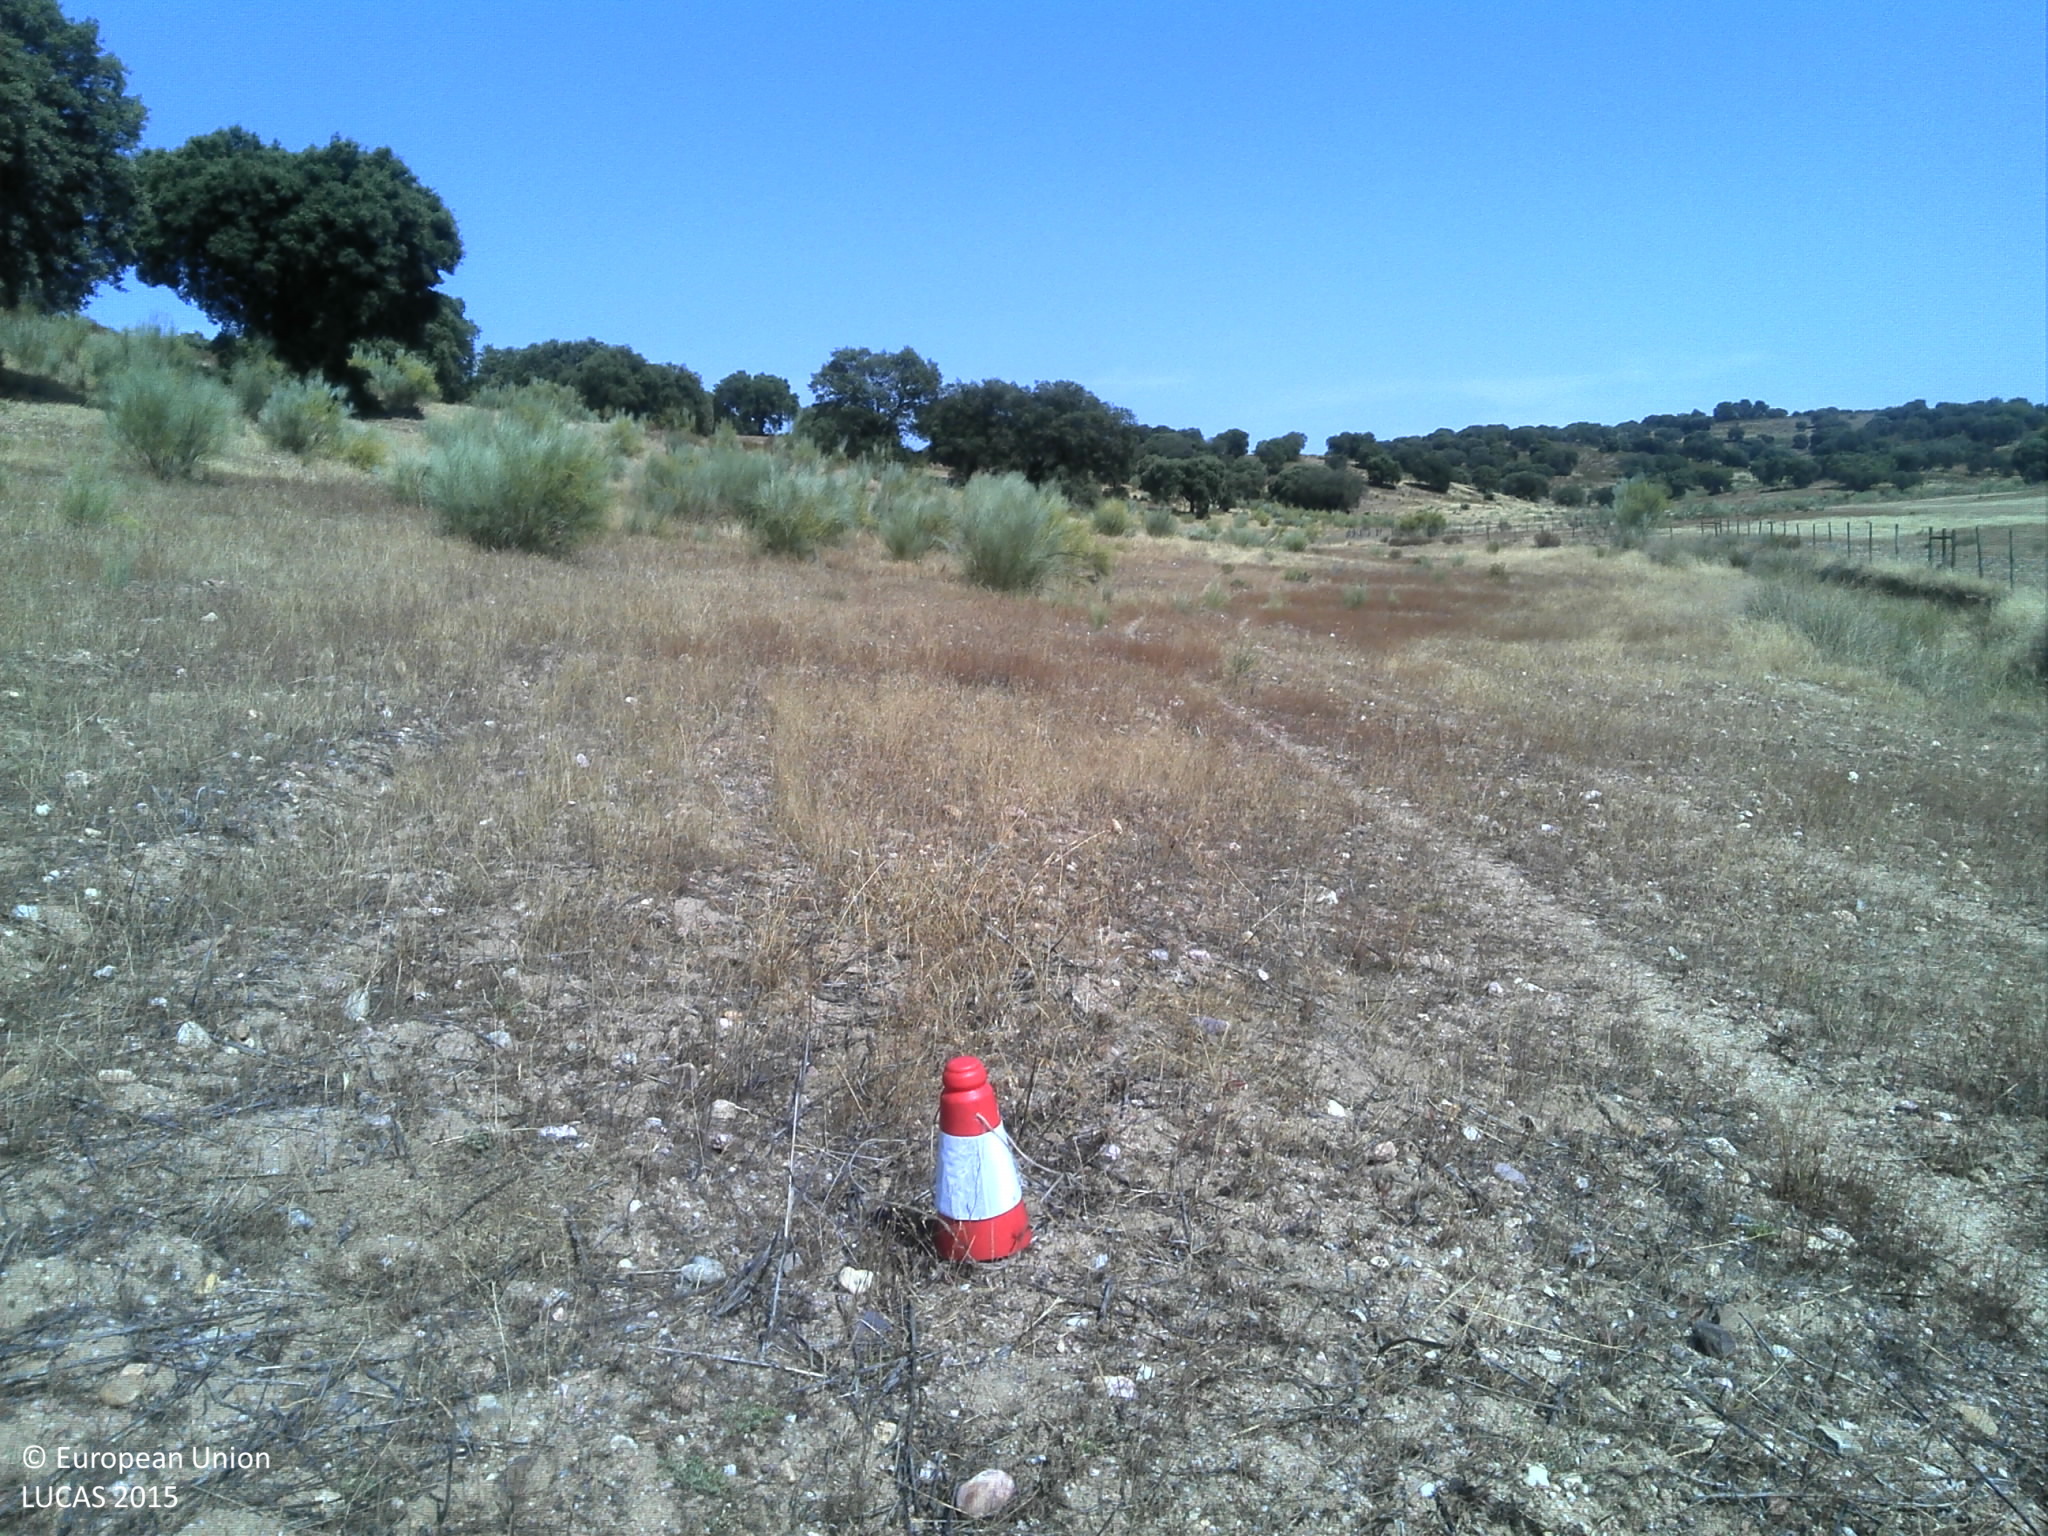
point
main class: Grassland
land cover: Grassland without tree/shrub cover
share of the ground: 10 - 25 %
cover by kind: unconsolidated bare surface 75 %, herbaceous plants 25 %
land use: Agriculture (excluding fallow land and kitchen gardens)
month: June
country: PT
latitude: 39.7683
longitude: -7.0976
